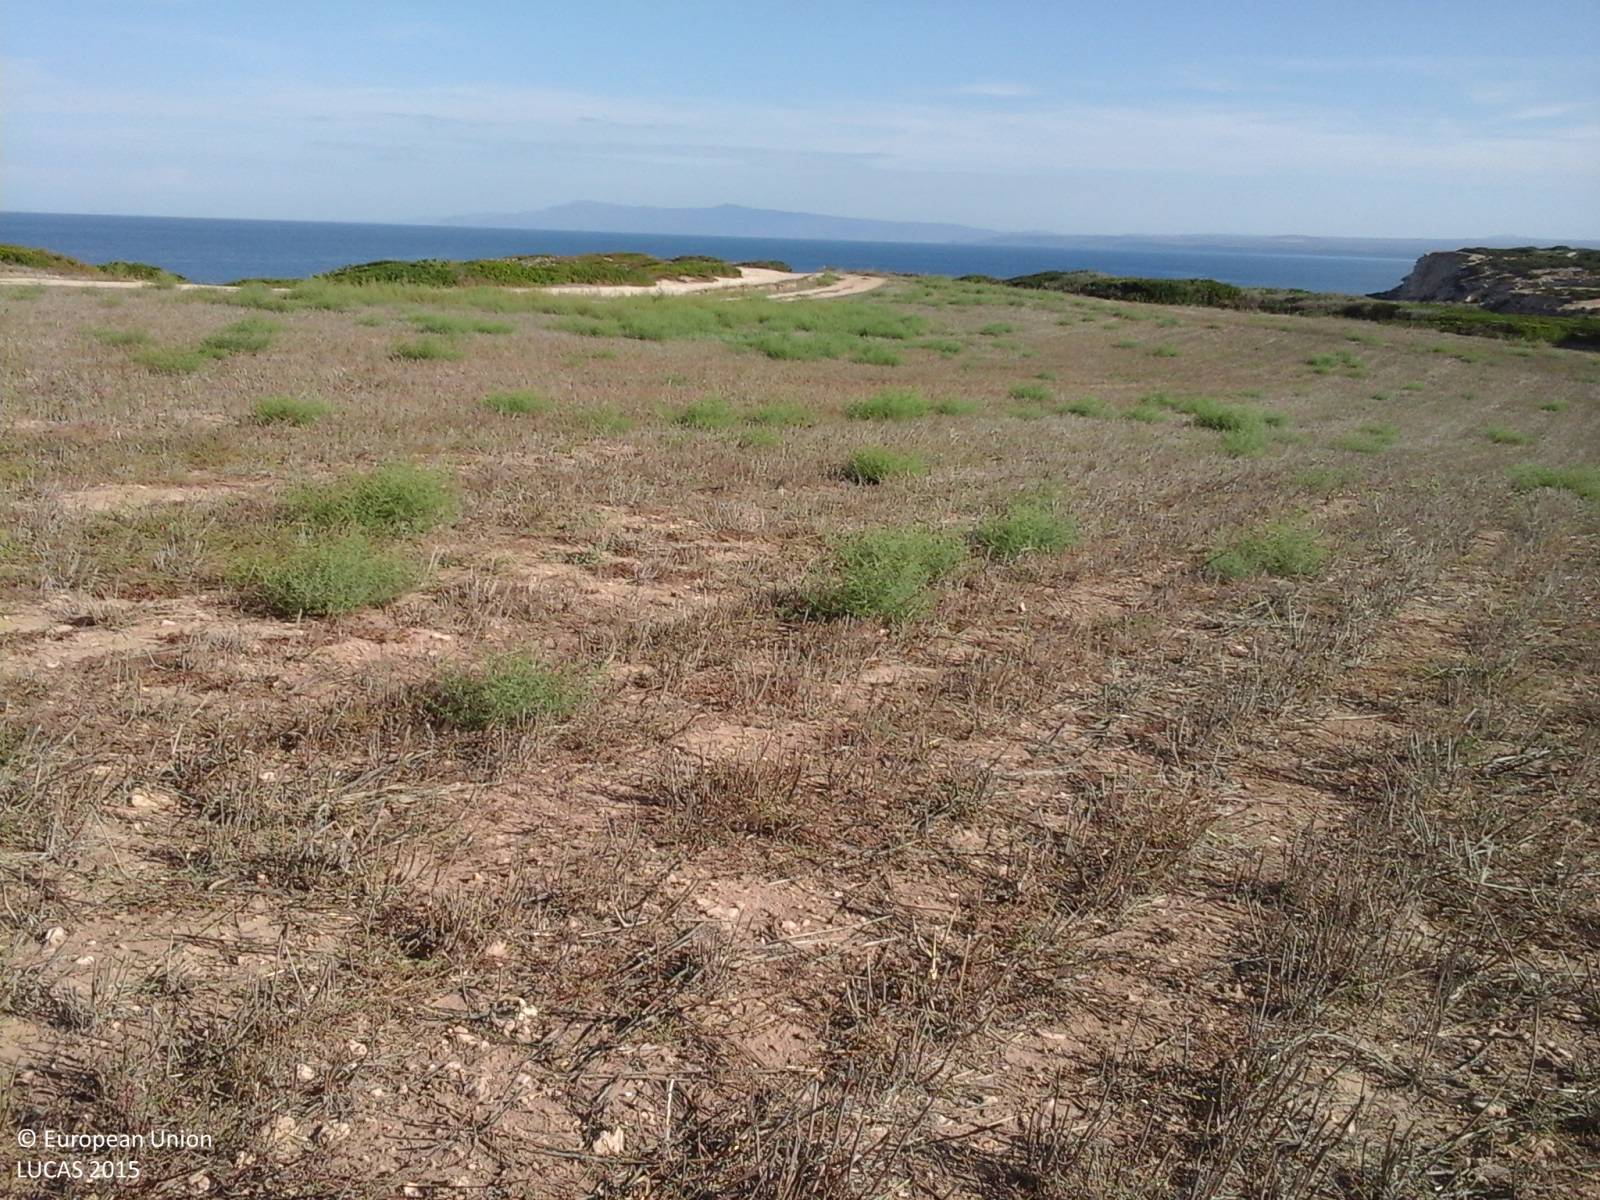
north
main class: Cropland
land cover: Mixed cereals for fodder
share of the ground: 10 - 25 %
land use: Agriculture (excluding fallow land and kitchen gardens)
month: September
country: IT
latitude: 40.0367
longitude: 8.3797
